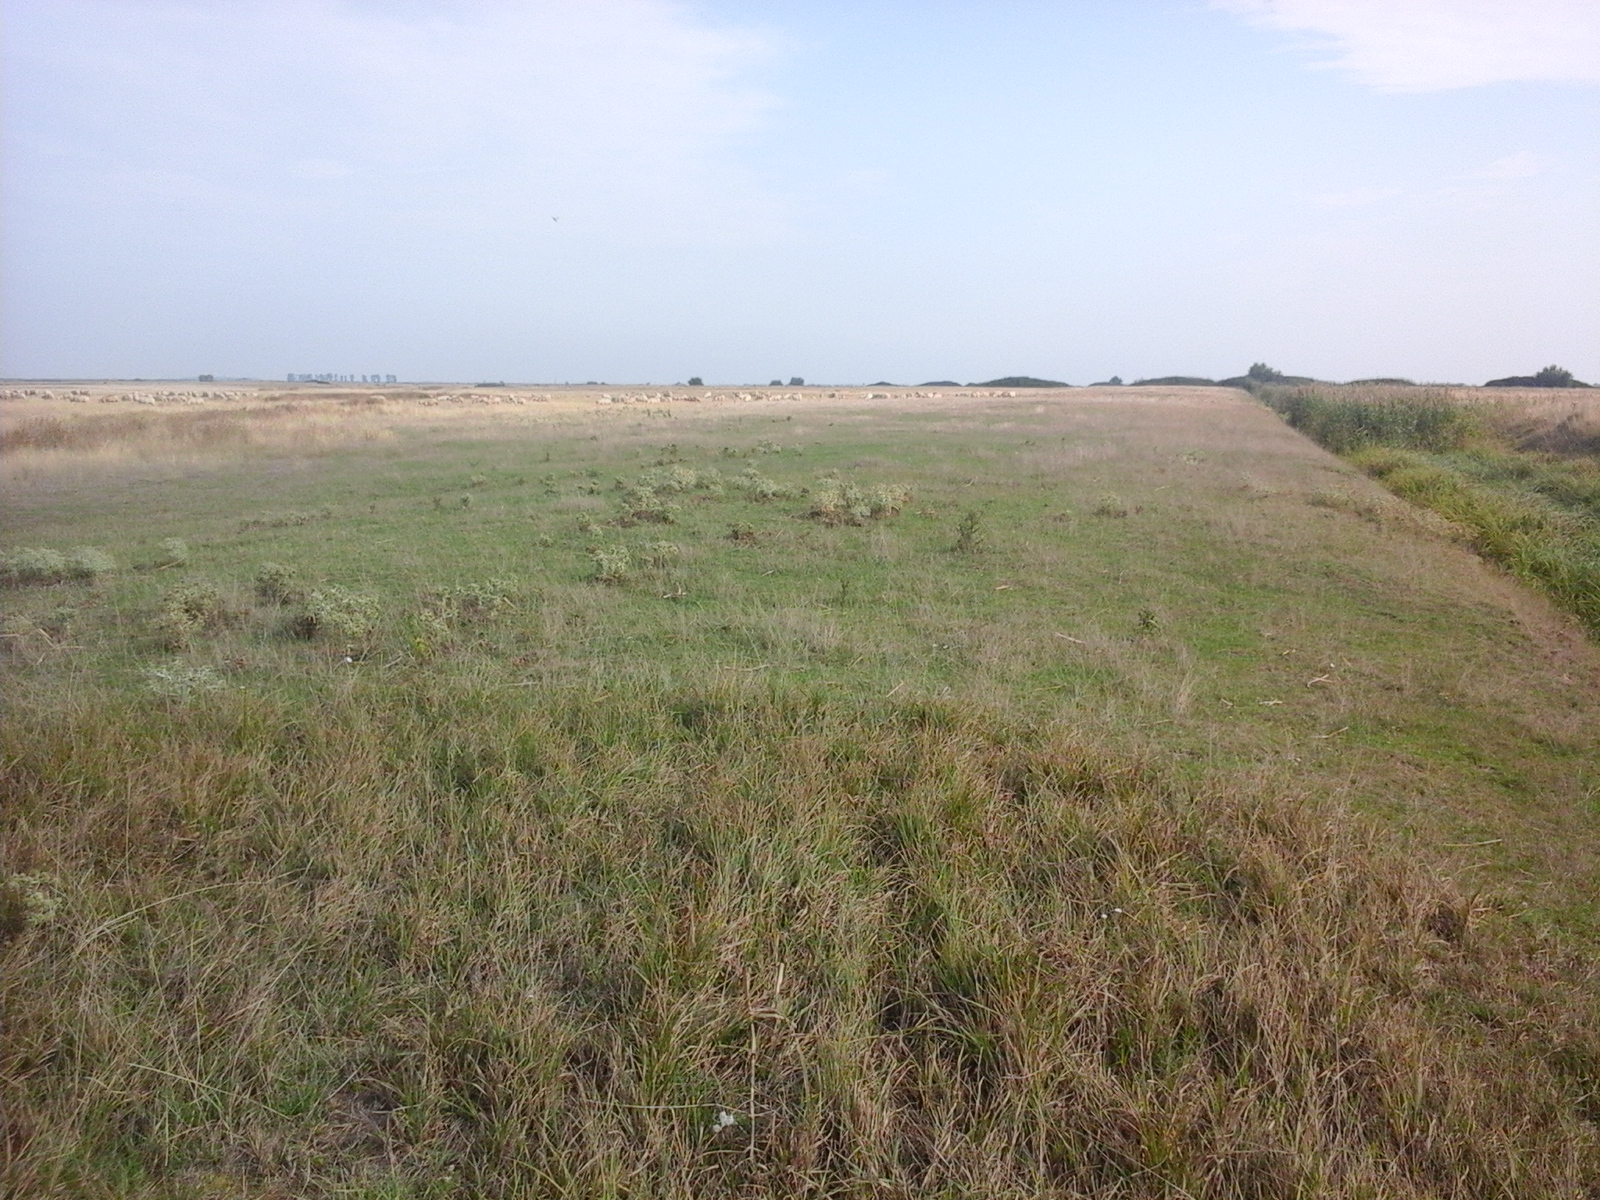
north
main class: Grassland
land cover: Grassland without tree/shrub cover
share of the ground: > 75 %
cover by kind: herbaceous plants 100 %
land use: Agriculture (excluding fallow land and kitchen gardens)
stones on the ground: < 10 %
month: August
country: RO
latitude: 46.7422
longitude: 21.5443
